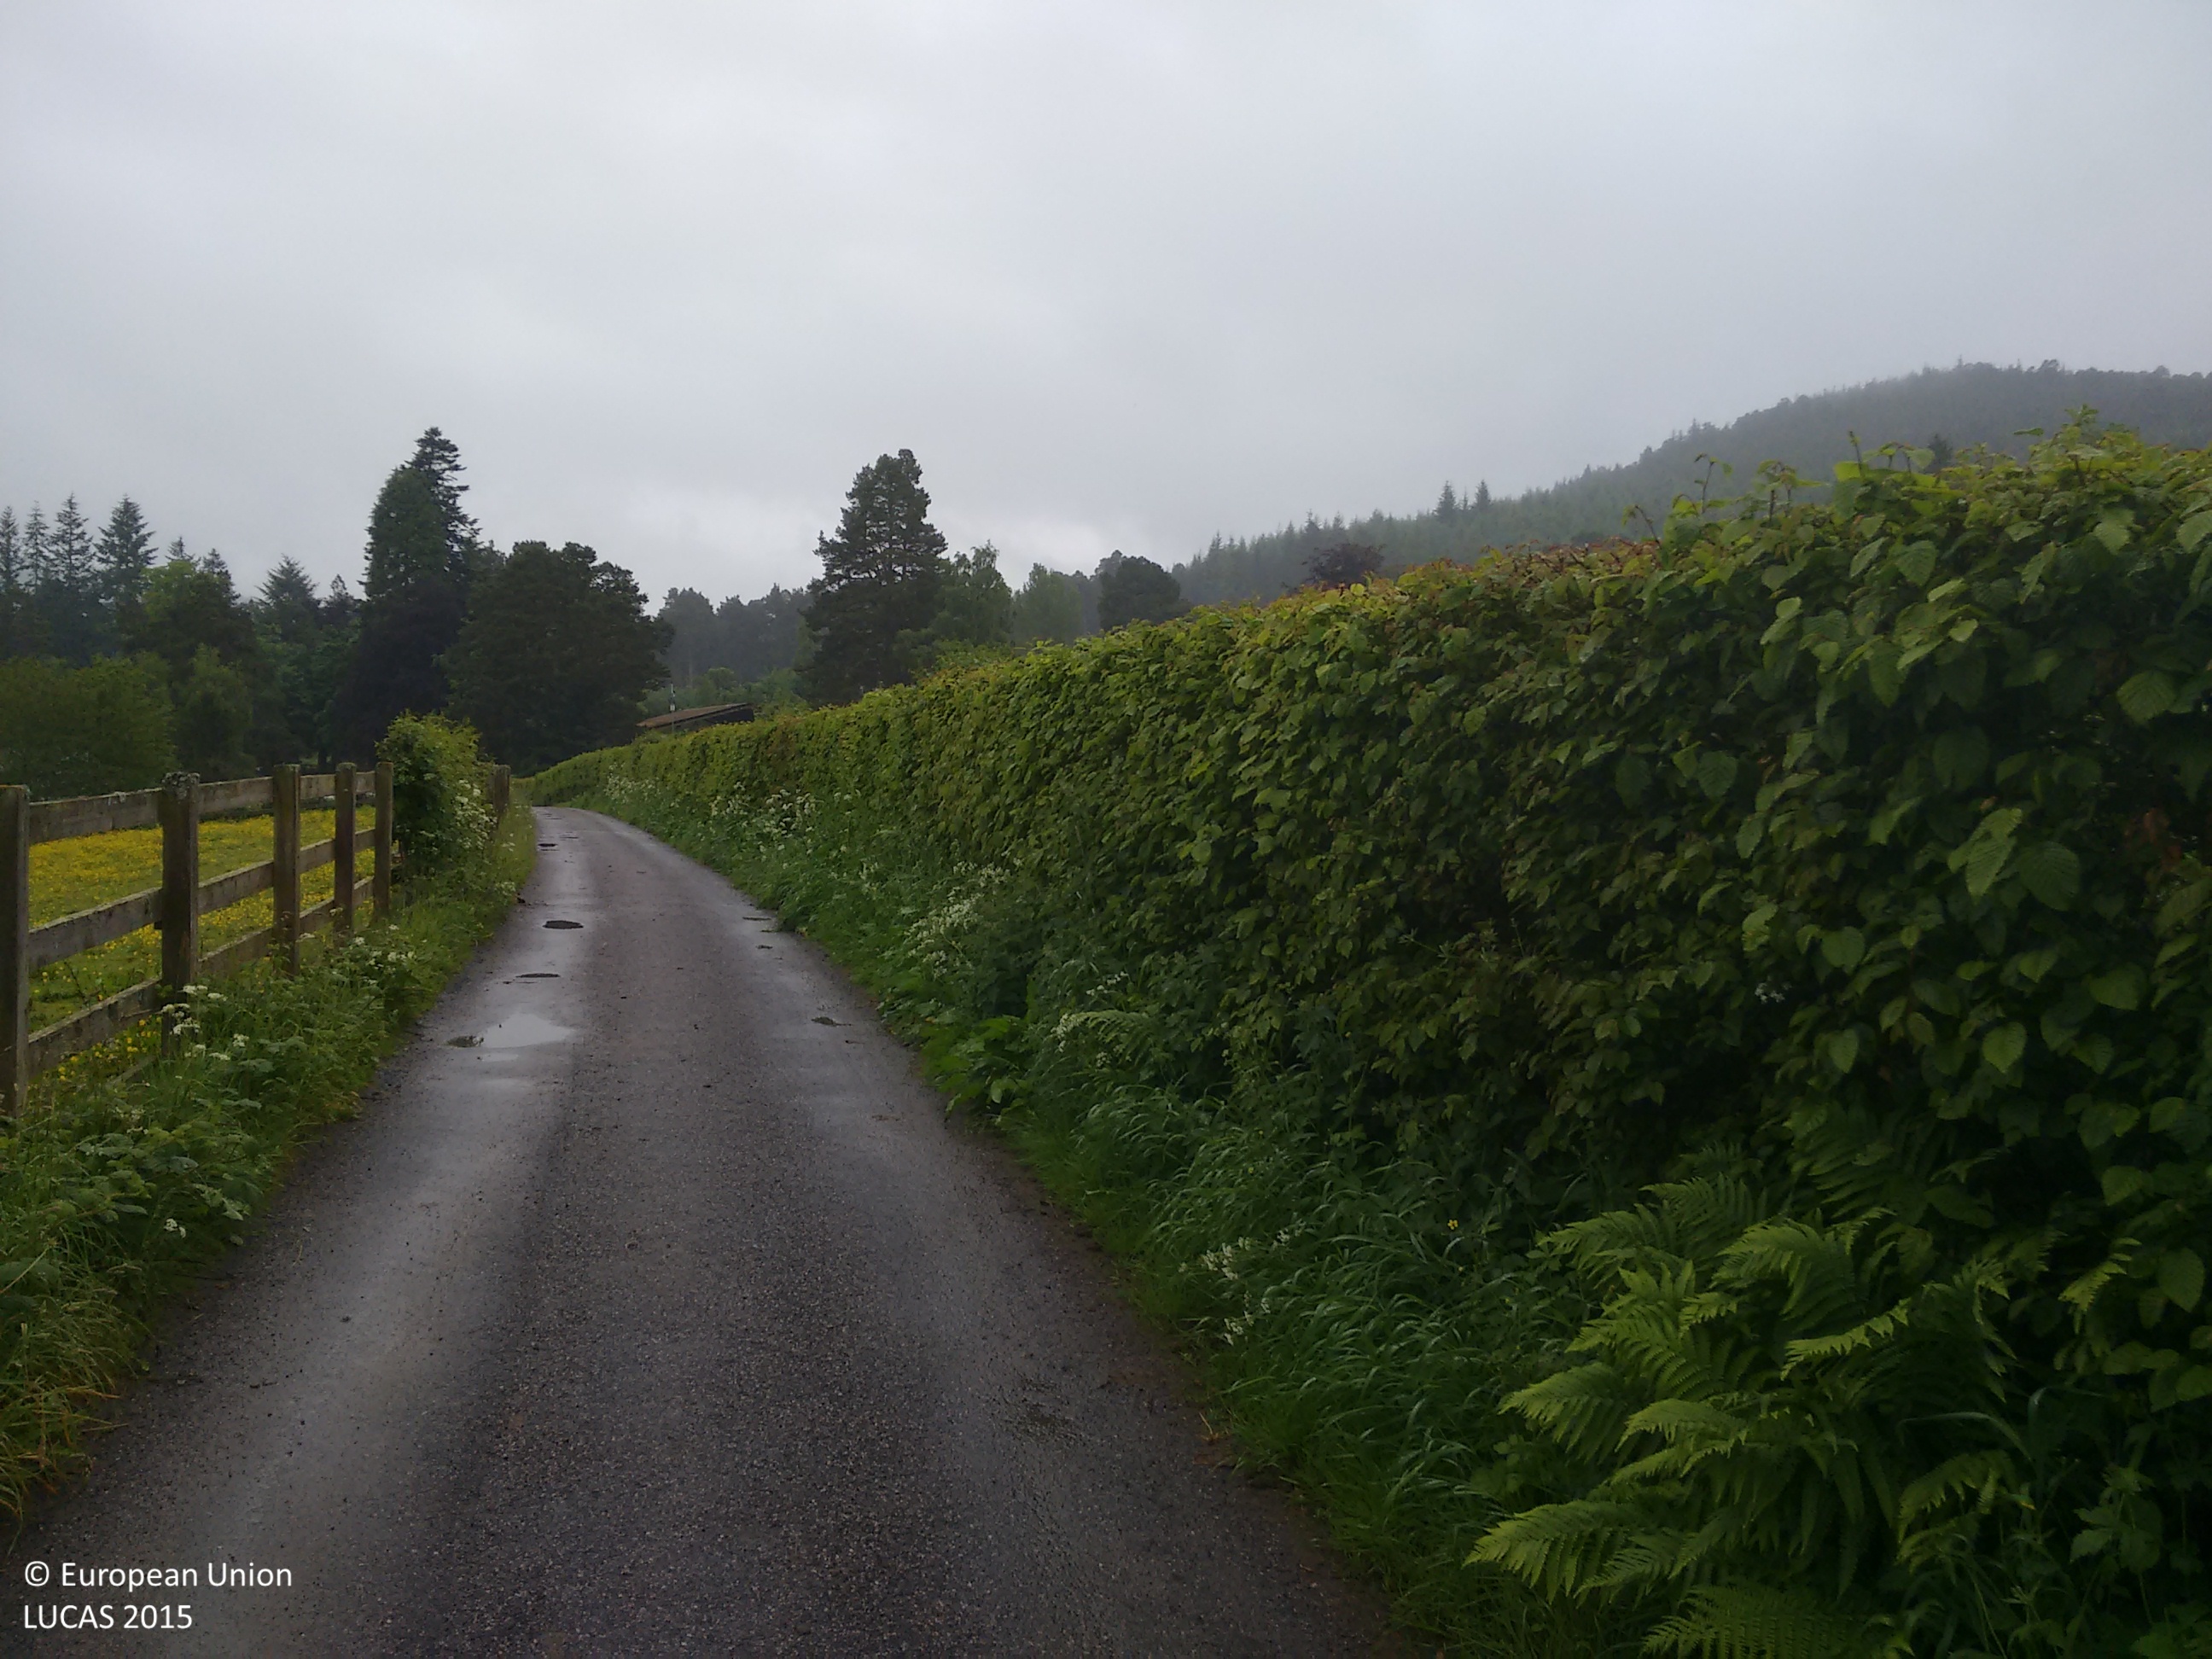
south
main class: Shrubland
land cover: Shrubland without tree cover
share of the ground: > 75 %
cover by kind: shrubs 50 %, herbaceous plants 50 %
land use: Semi-natural and natural areas not in use
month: June
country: GB
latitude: 57.0500
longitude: -2.8698
